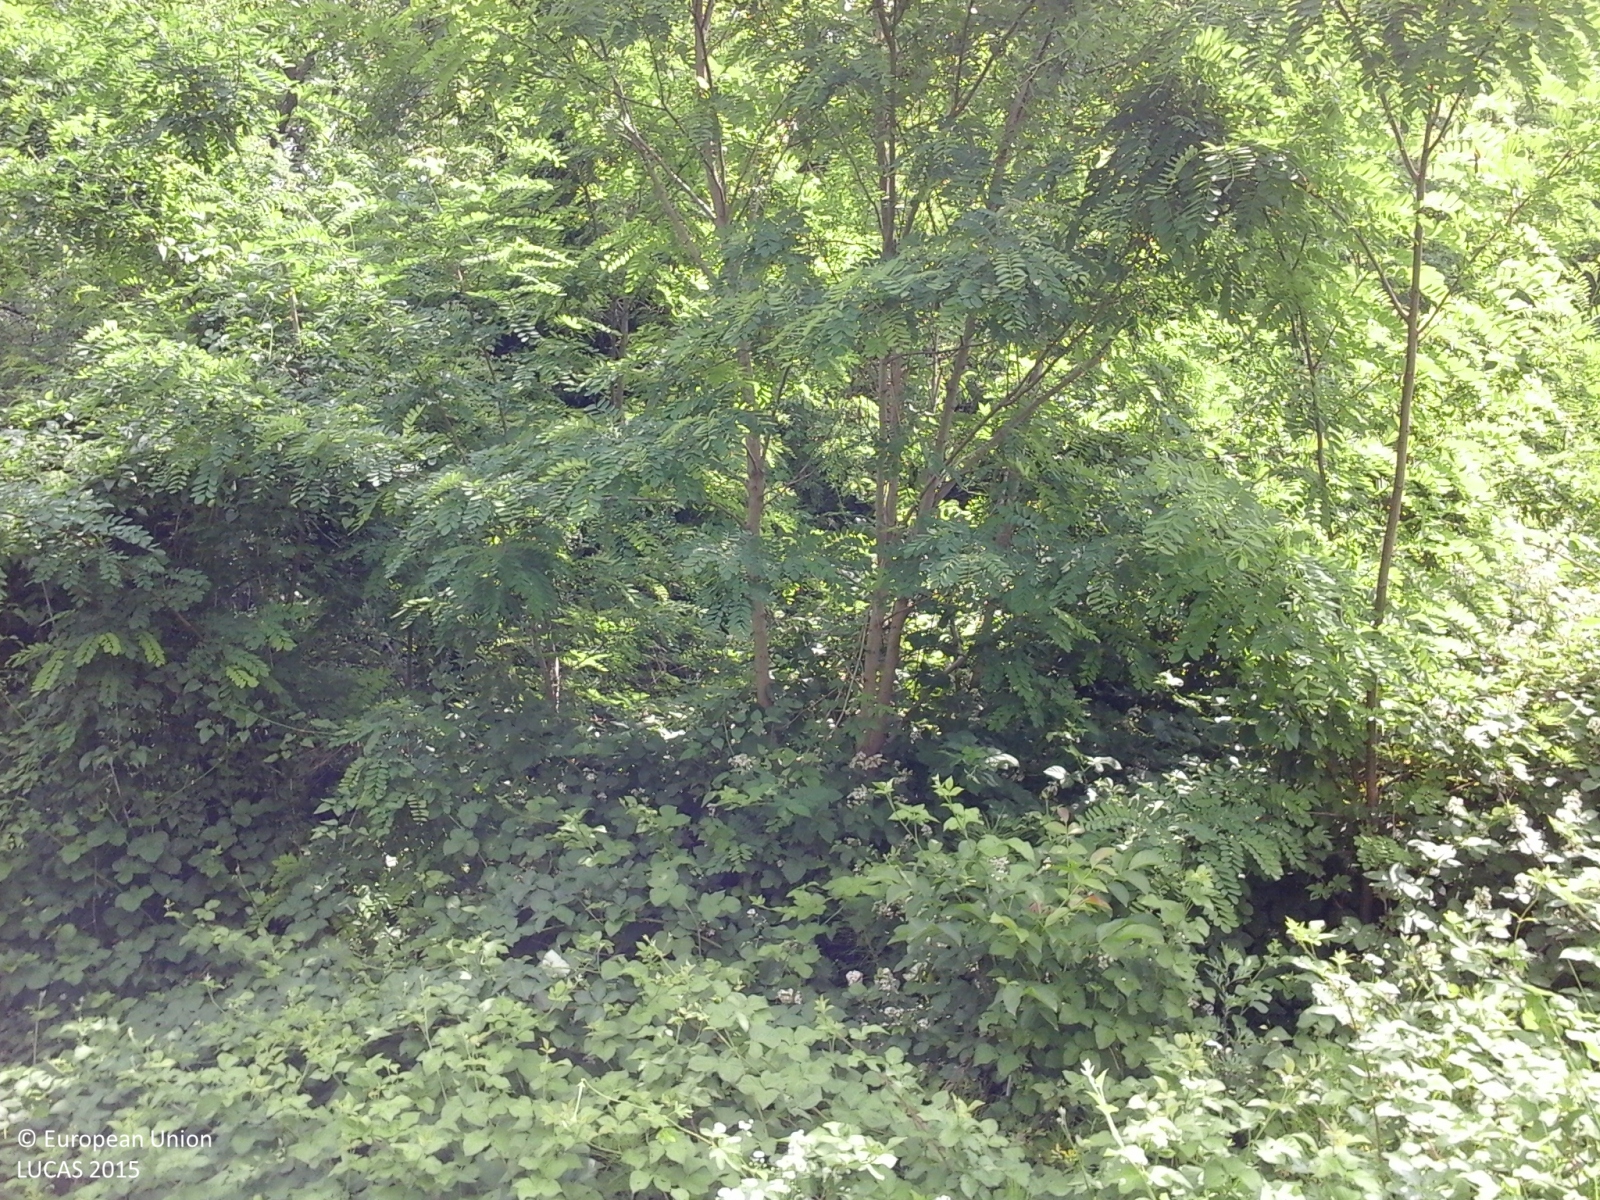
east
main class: Shrubland
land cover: Shrubland with sparse tree cover
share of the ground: > 75 %
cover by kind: shrubs 95 %, broadleaved forest trees 5 %
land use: Semi-natural and natural areas not in use
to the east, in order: Shrubland with sparse tree cover; Broadleaved woodland; Tracks; Shrubland with sparse tree cover; Broadleaved woodland; Tracks; Broadleaved woodland
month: June
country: IT
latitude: 44.8550
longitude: 9.6843
